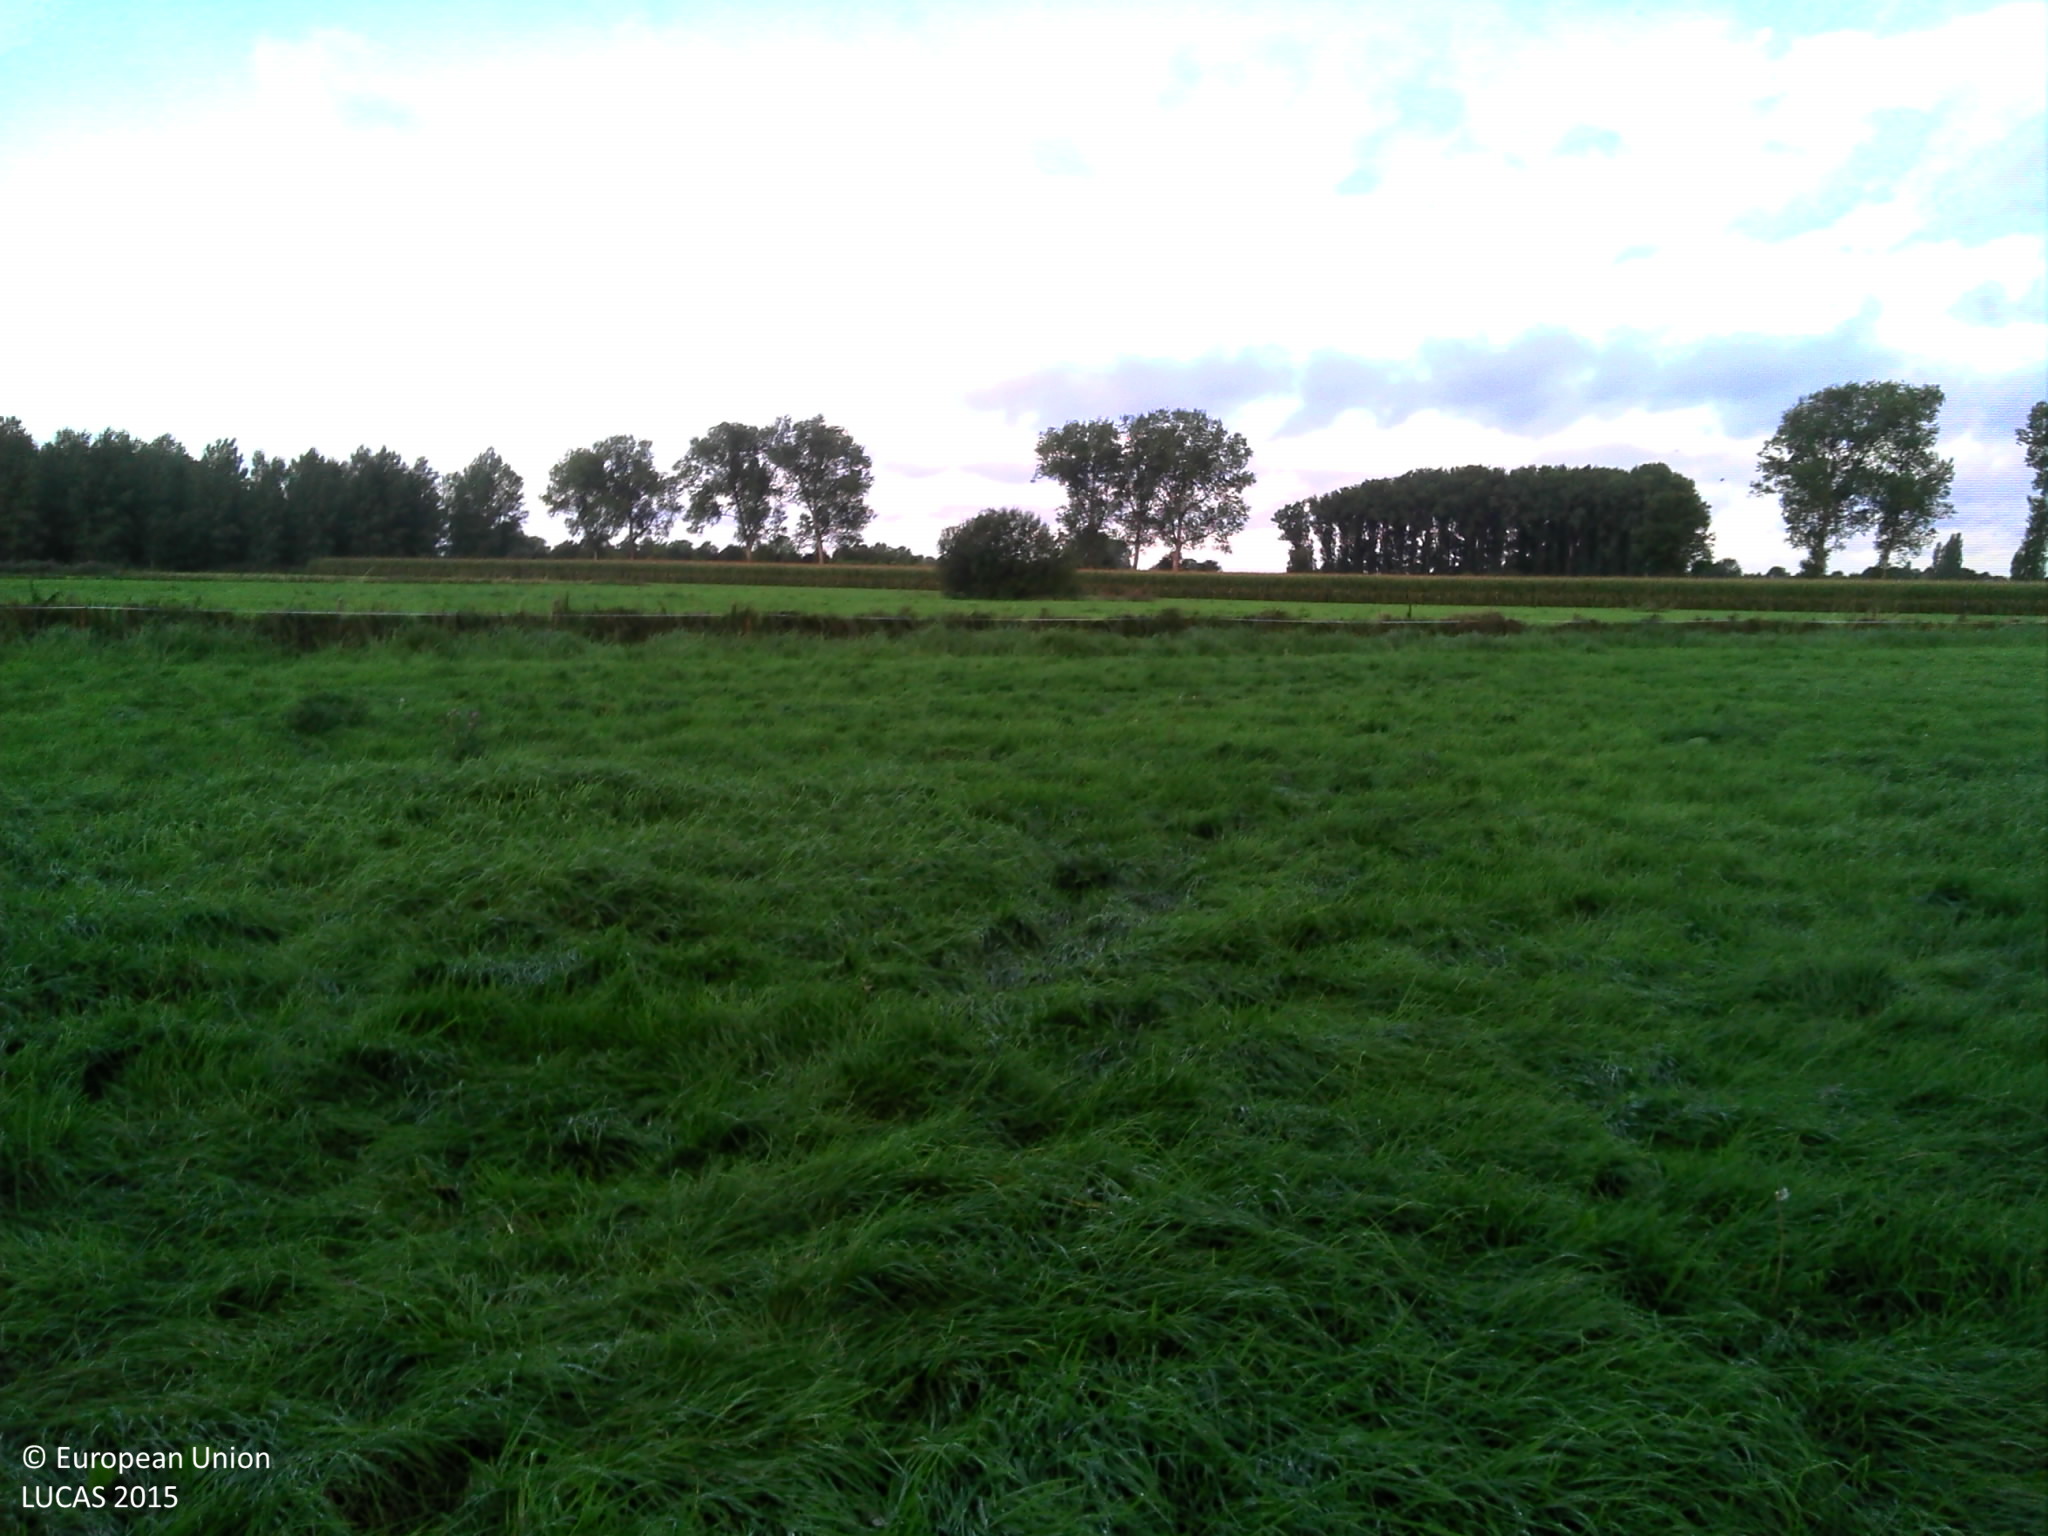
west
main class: Grassland
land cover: Grassland without tree/shrub cover
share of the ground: > 75 %
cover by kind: herbaceous plants 100 %
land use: Agriculture (excluding fallow land and kitchen gardens)
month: September
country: BE
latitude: 51.4094
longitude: 4.6336
